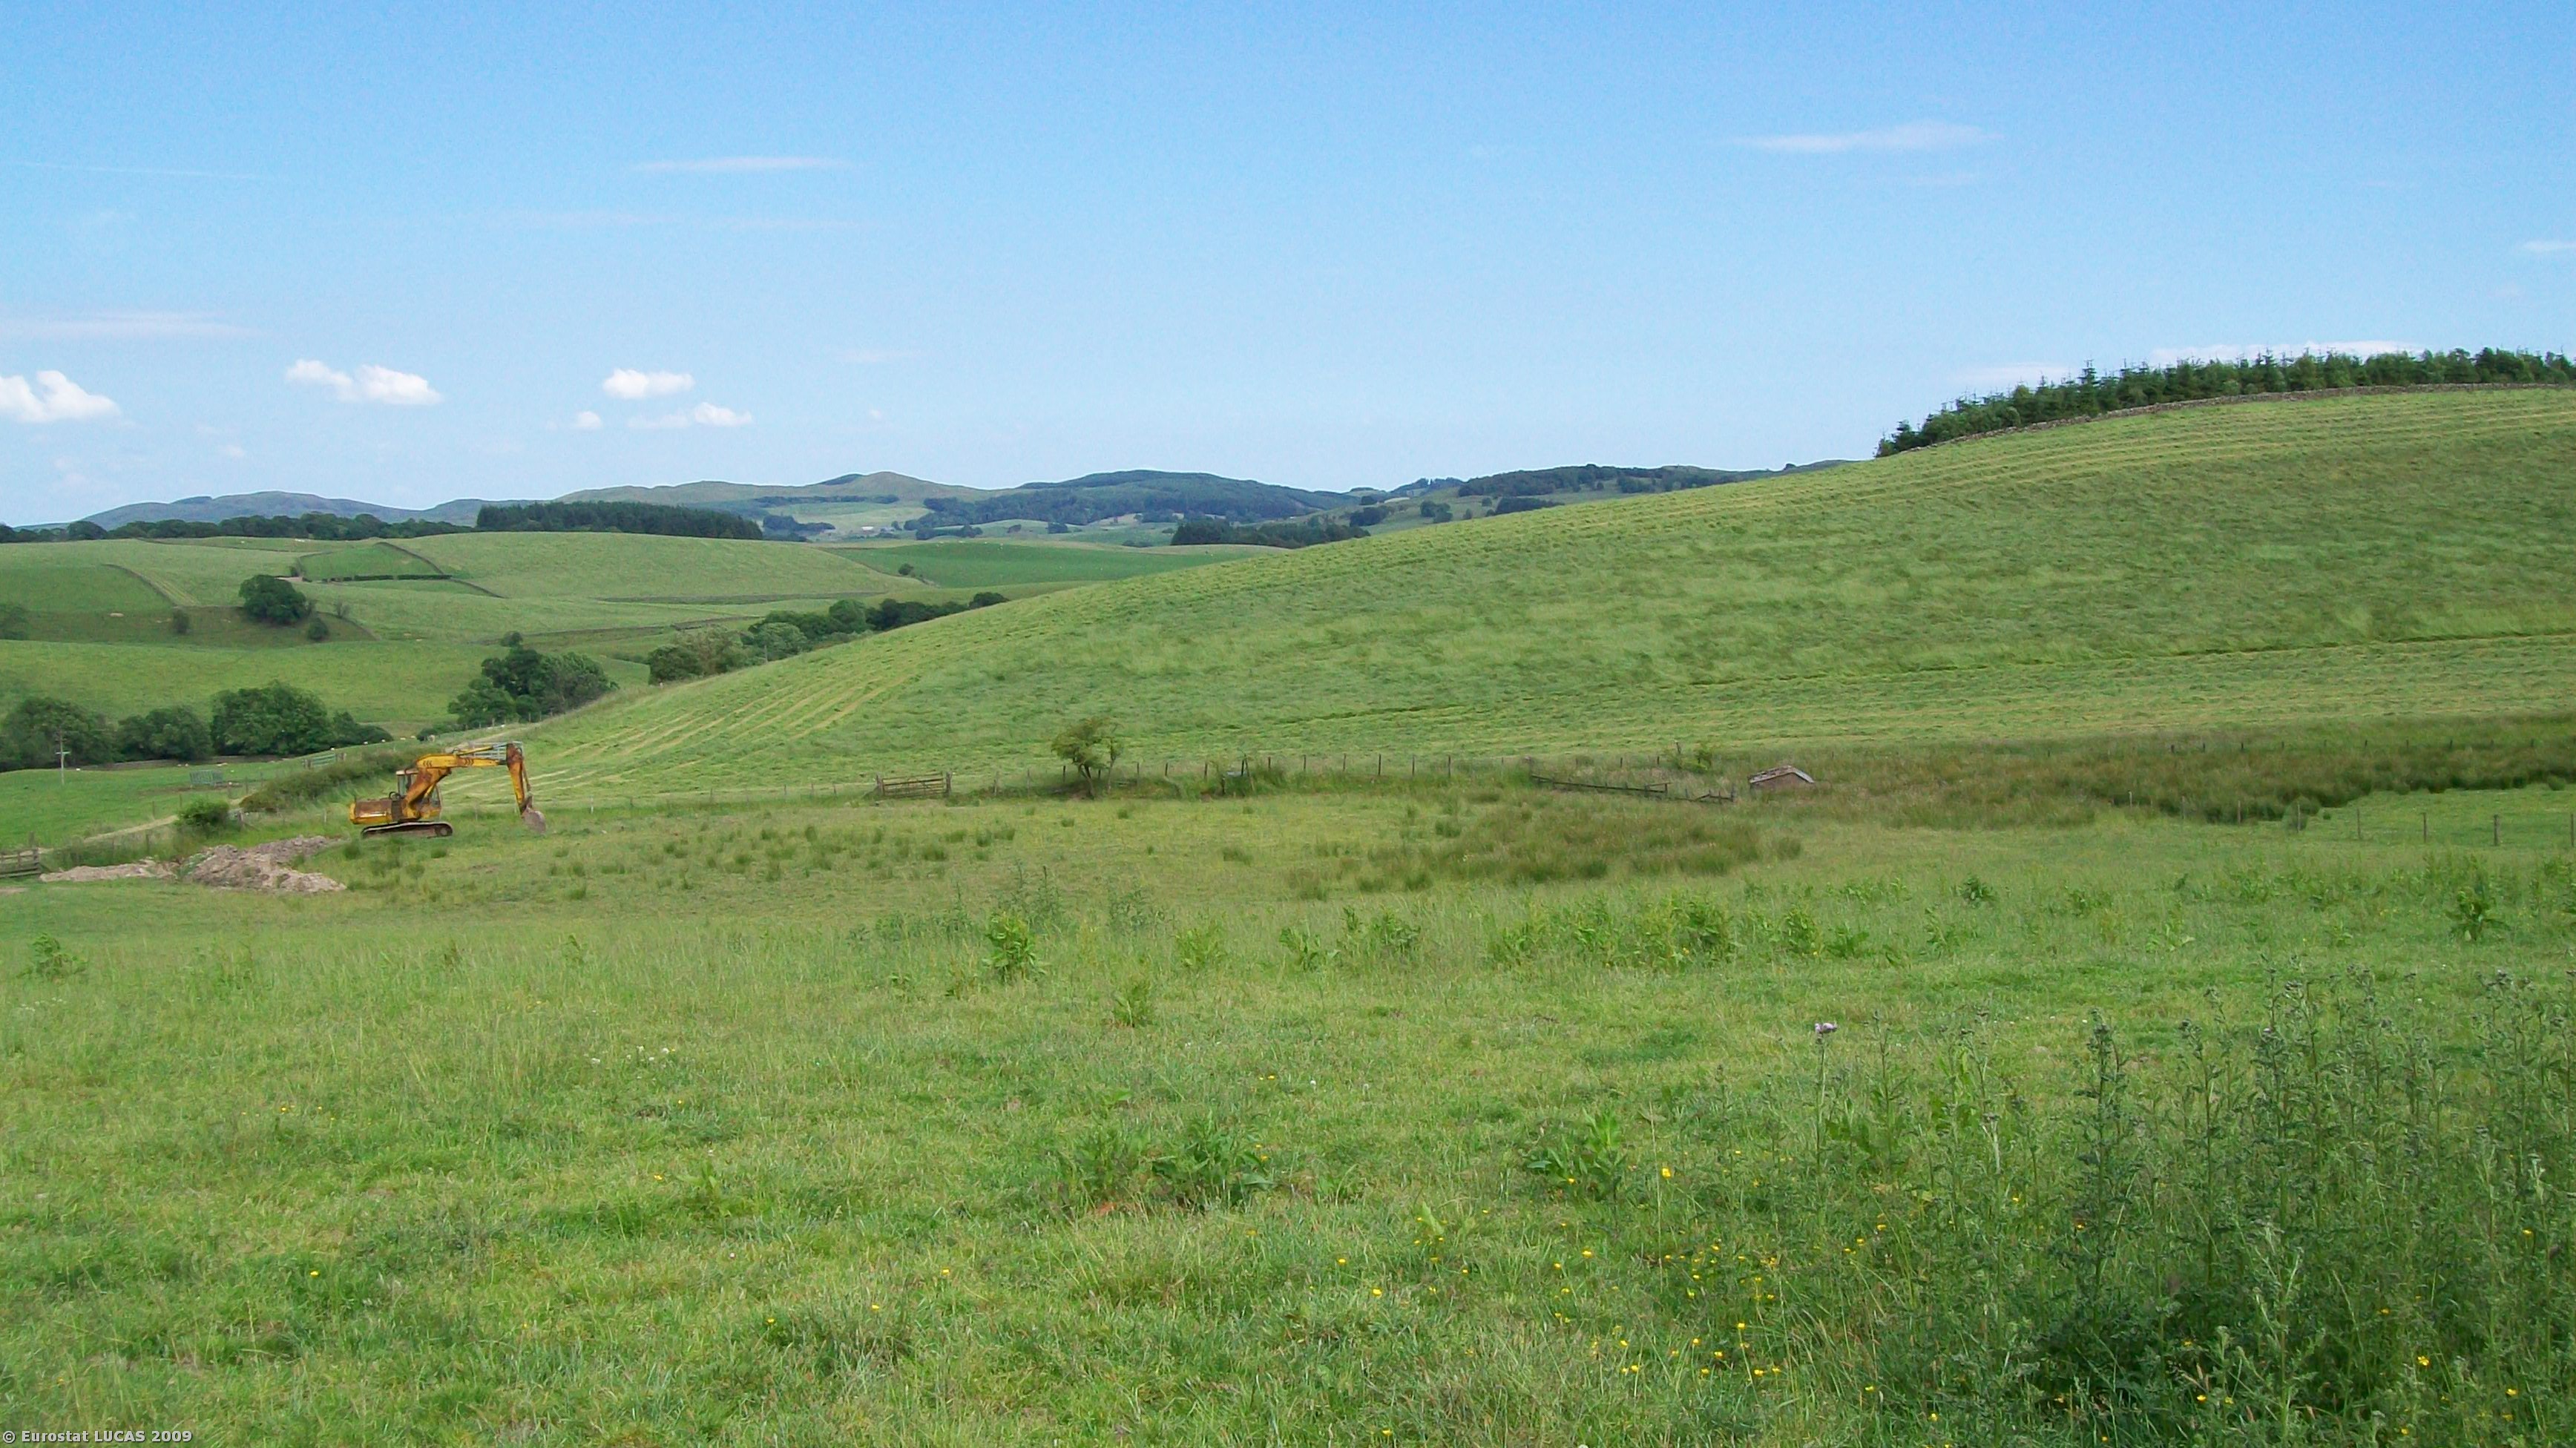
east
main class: Grassland
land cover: Grassland without tree/shrub cover
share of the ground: > 75 %
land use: Agriculture (excluding fallow land and kitchen gardens)
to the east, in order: Grassland without tree/shrub cover; Fences; Grassland without tree/shrub cover; Ditches and canals; Grassland without tree/shrub cover; Fences; Grassland without tree/shrub cover
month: July
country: GB
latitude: 55.0347
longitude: -3.9685
